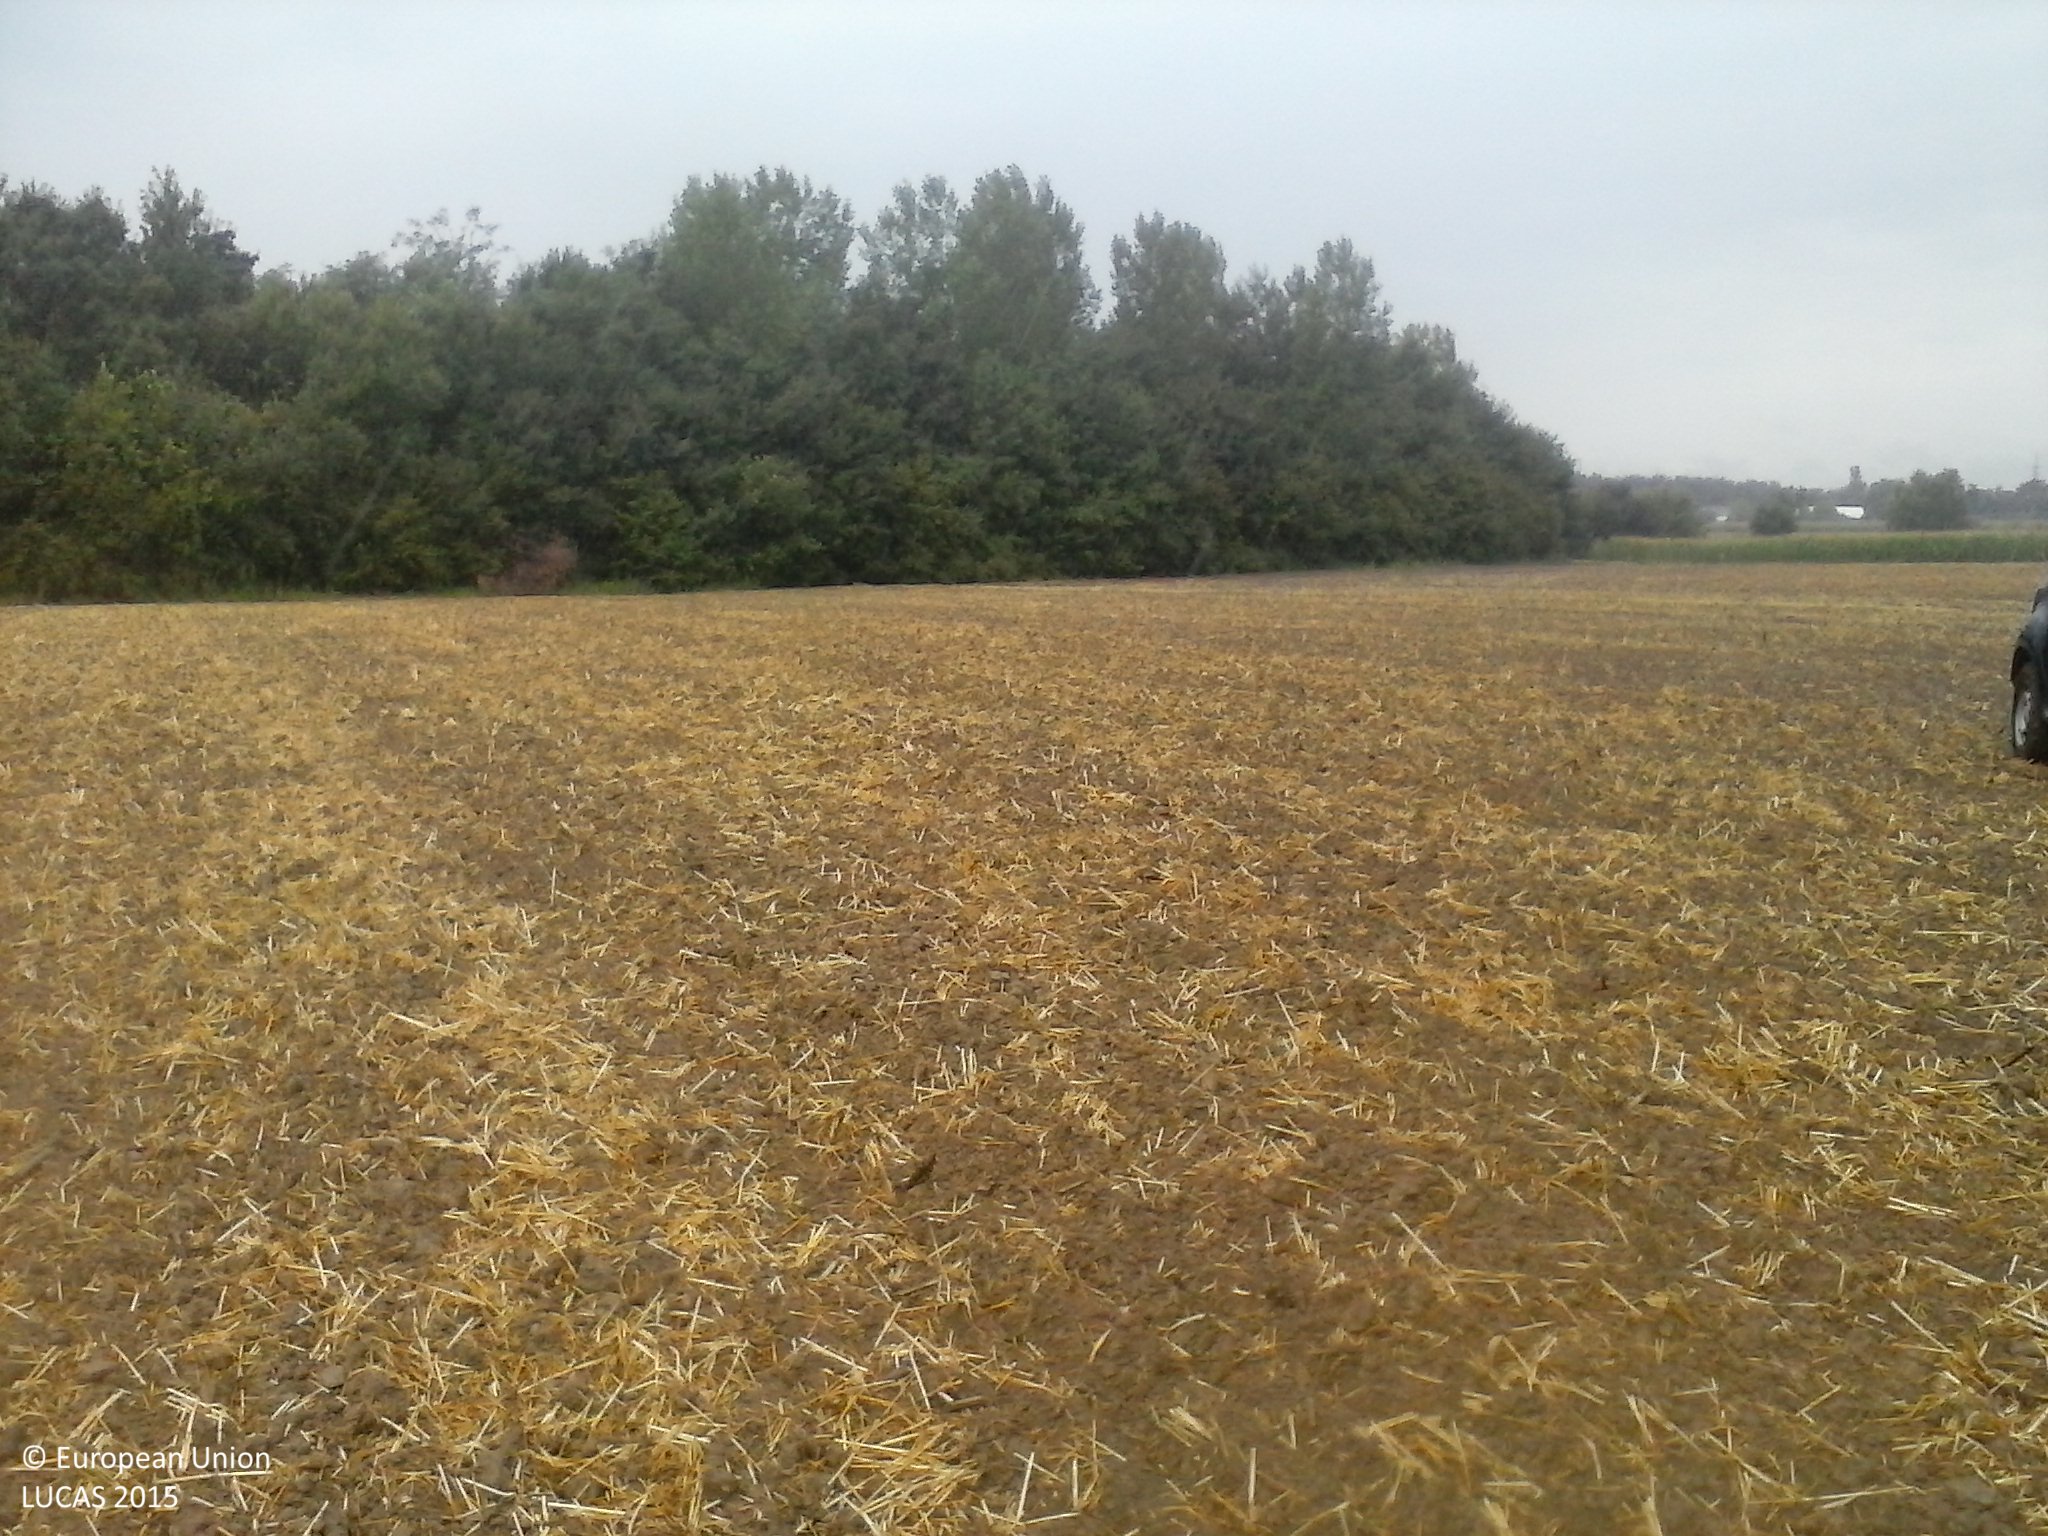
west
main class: Cropland
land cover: Common wheat
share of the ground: 25 - 50 %
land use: Agriculture (excluding fallow land and kitchen gardens)
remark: Harvested field
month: July
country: HU
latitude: 45.9896
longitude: 17.6077
